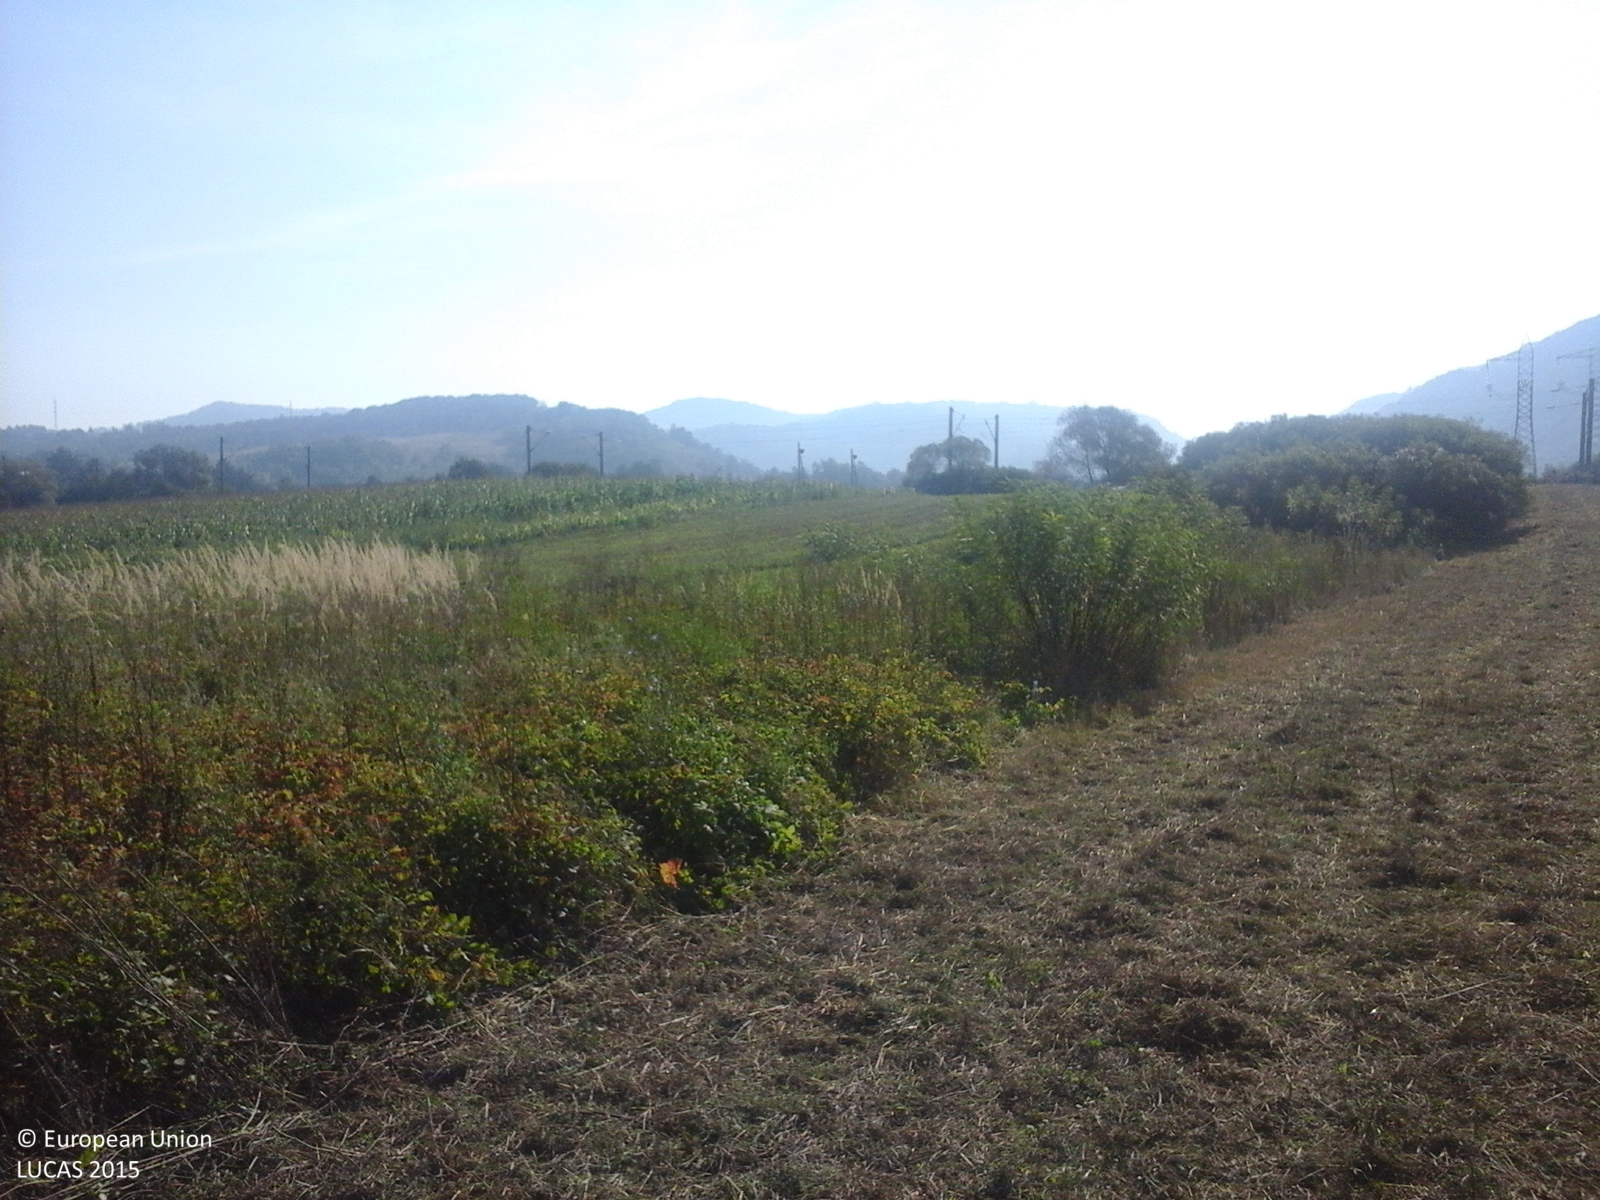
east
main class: Grassland
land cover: Grassland without tree/shrub cover
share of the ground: > 75 %
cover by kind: herbaceous plants 100 %
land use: Agriculture (excluding fallow land and kitchen gardens)
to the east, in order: Grassland without tree/shrub cover; Spontaneously vegetated surfaces; Lucerne; Oats; Maize; Grass margins; Tracks; Grass margins; Ditches and canals; Grass margins; Electric lines; Railways; Grass margins; Spontaneously vegetated surfaces; Ditches and canals; Spontaneously vegetated surfaces; Maize
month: August
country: RO
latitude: 45.9875
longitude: 22.4276
